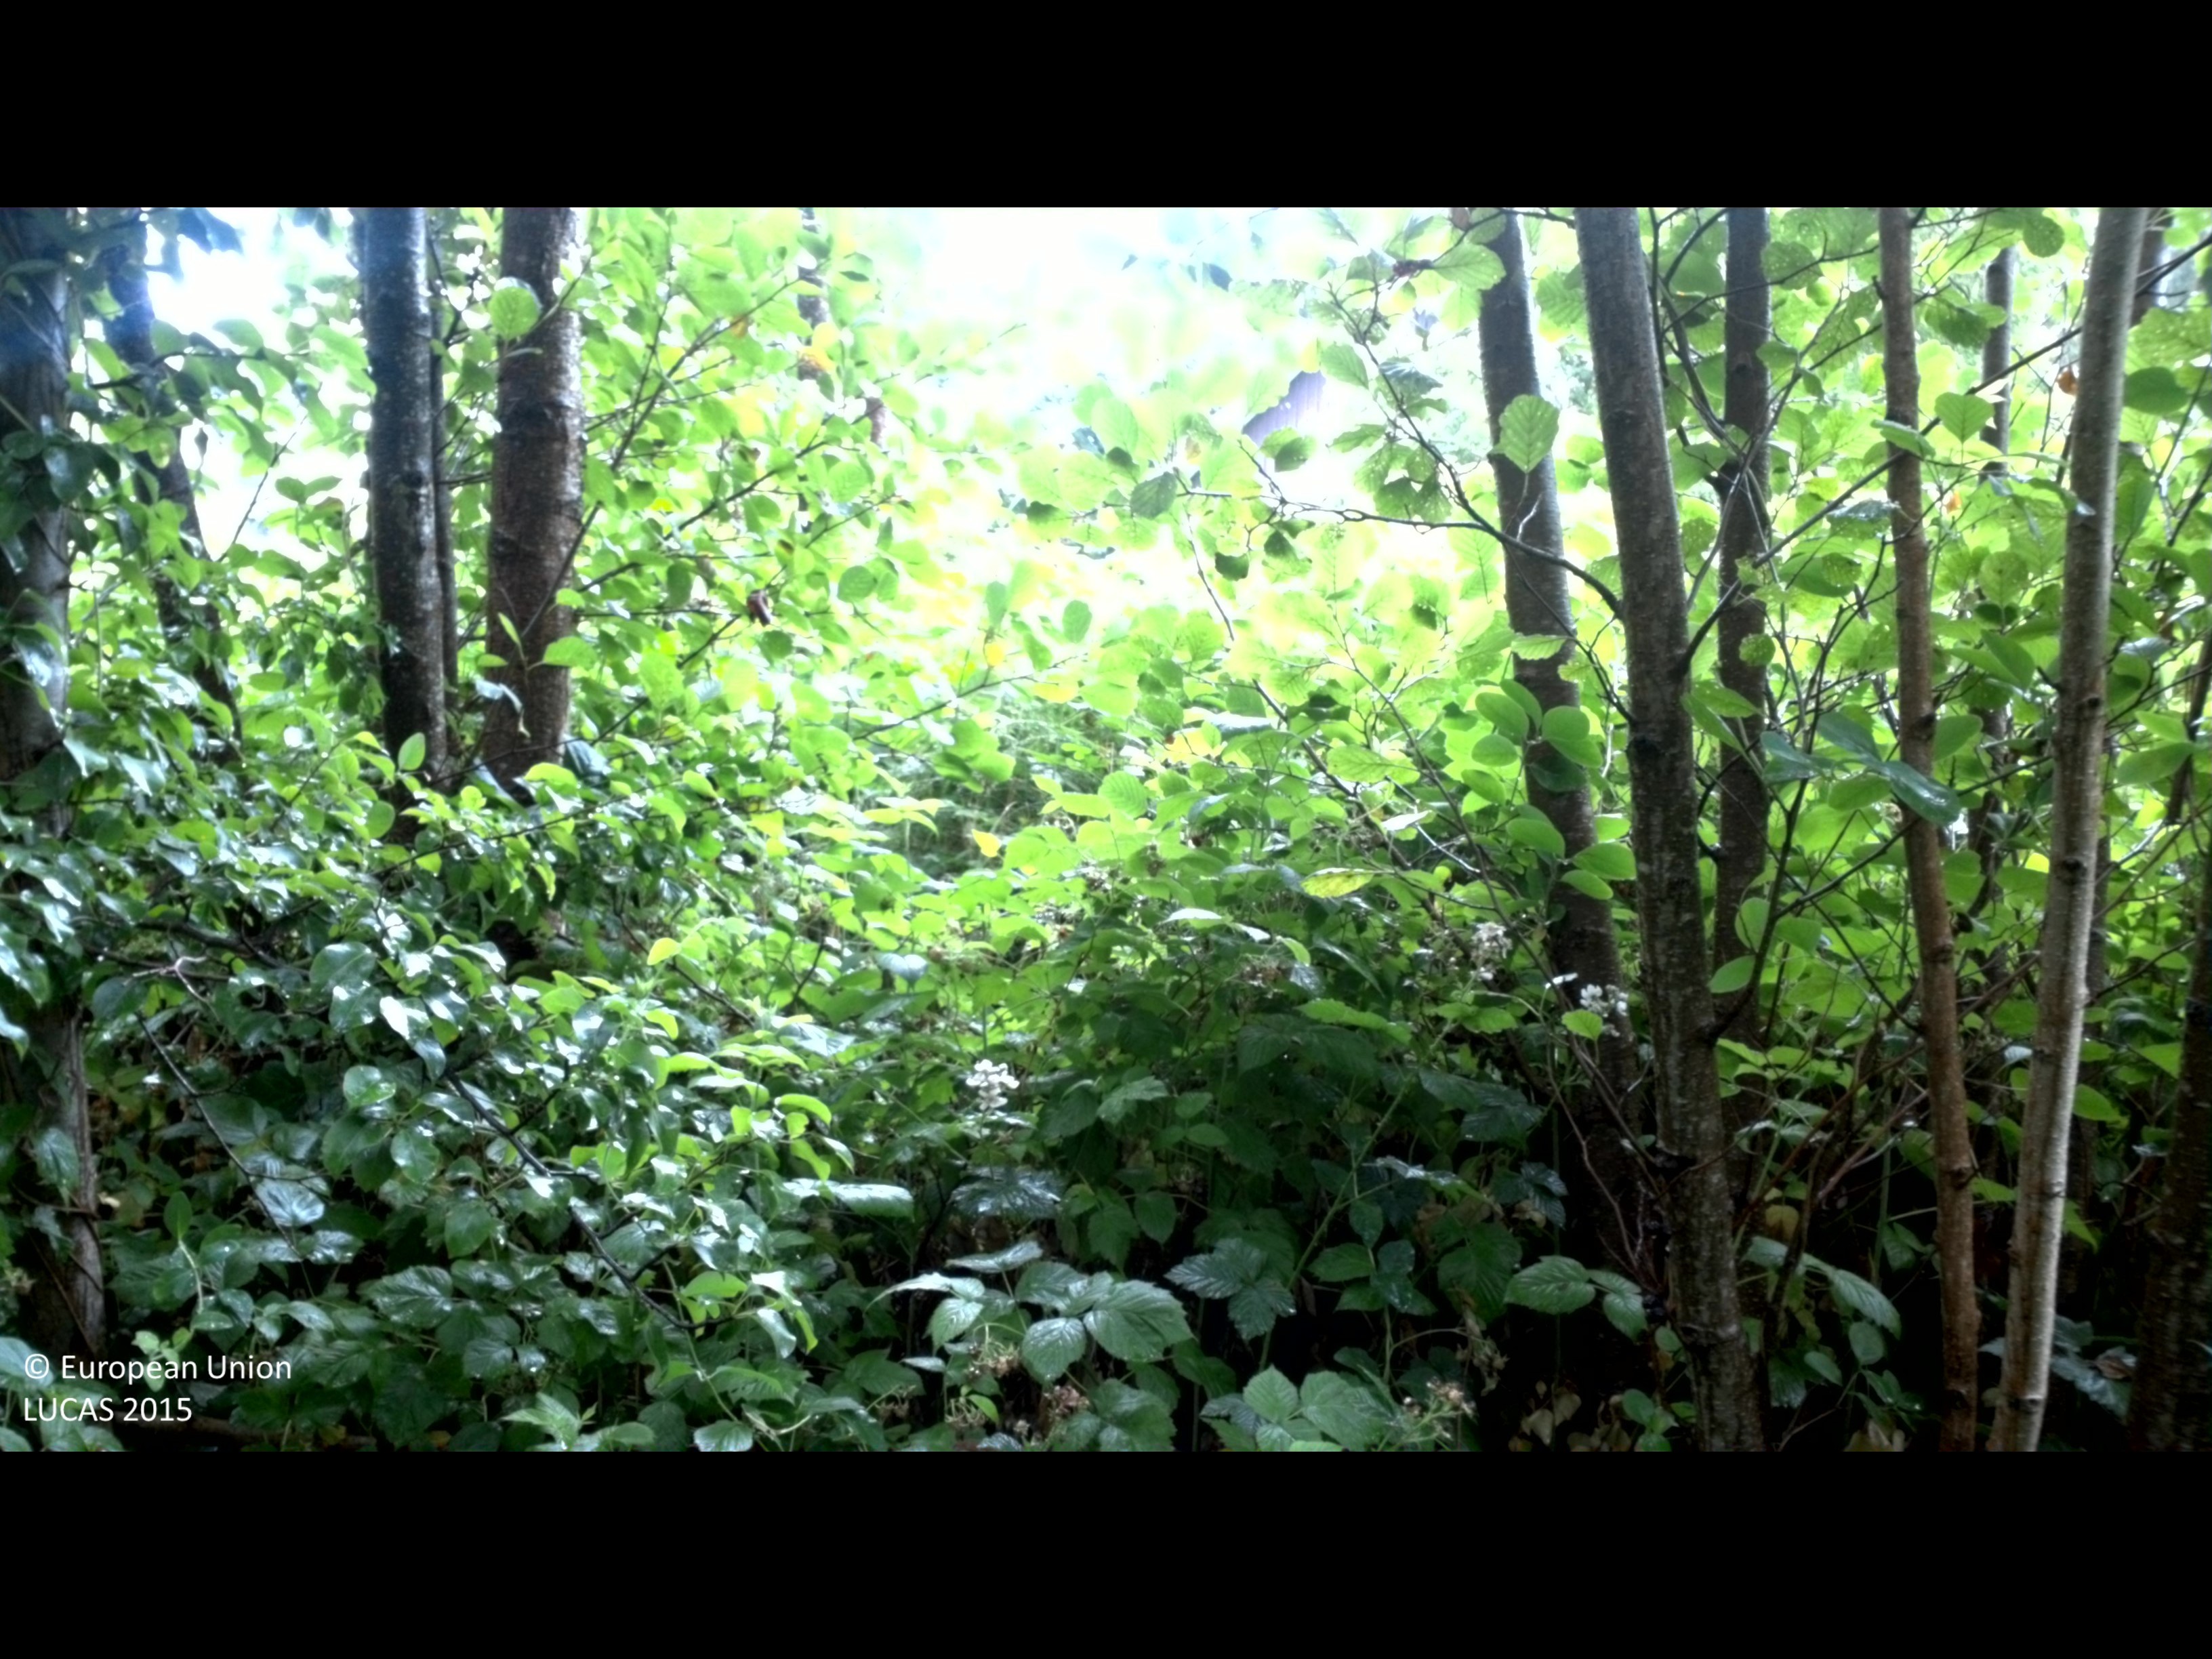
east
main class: Woodland
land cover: Broadleaved woodland
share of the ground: > 75 %
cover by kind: broadleaved forest trees 80 %, shrubs 20 %
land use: Amenities, museums, leisure
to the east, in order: Broadleaved woodland; Shrubland without tree cover; Artificial constructions in urban areas; Broadleaved woodland; Paved roads, cycling and walking lanes; Broadleaved woodland
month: July
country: SE
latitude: 56.6378
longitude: 16.4743
